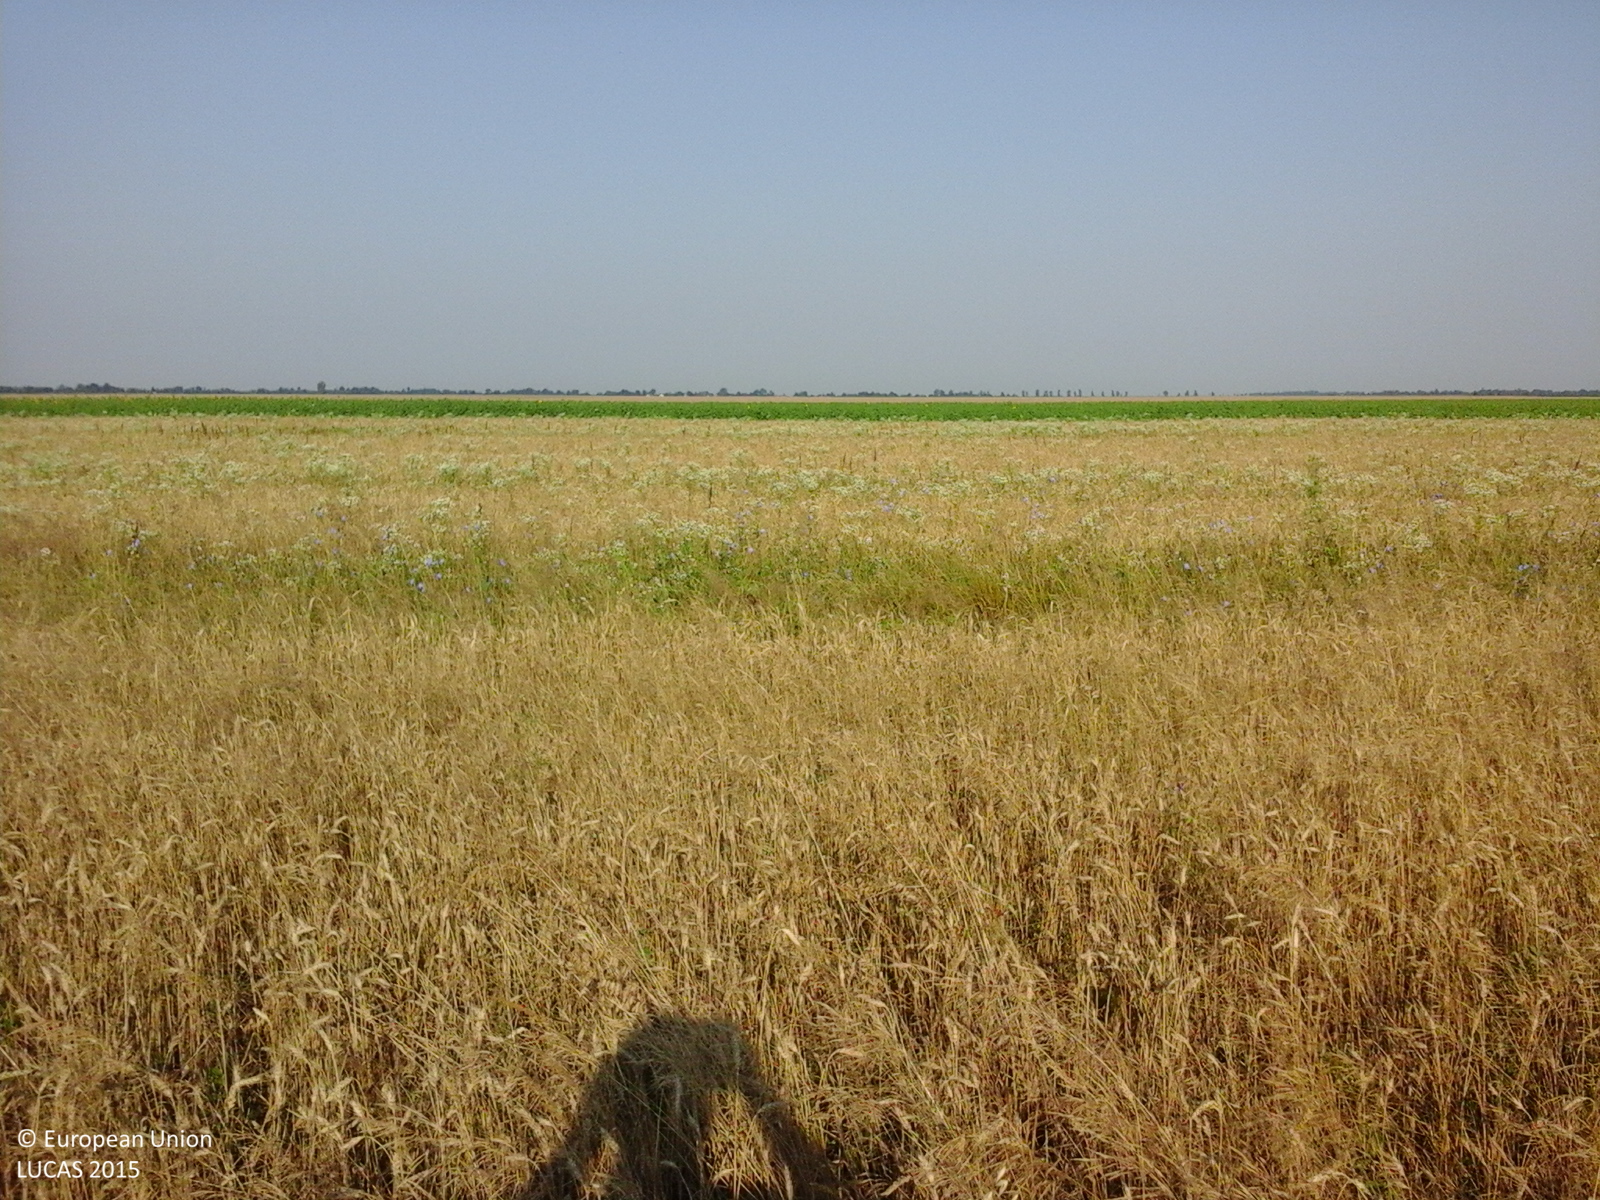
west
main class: Cropland
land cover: Common wheat
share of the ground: > 75 %
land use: Agriculture (excluding fallow land and kitchen gardens)
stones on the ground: < 10 %
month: July
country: RO
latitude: 44.4796
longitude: 25.0046
